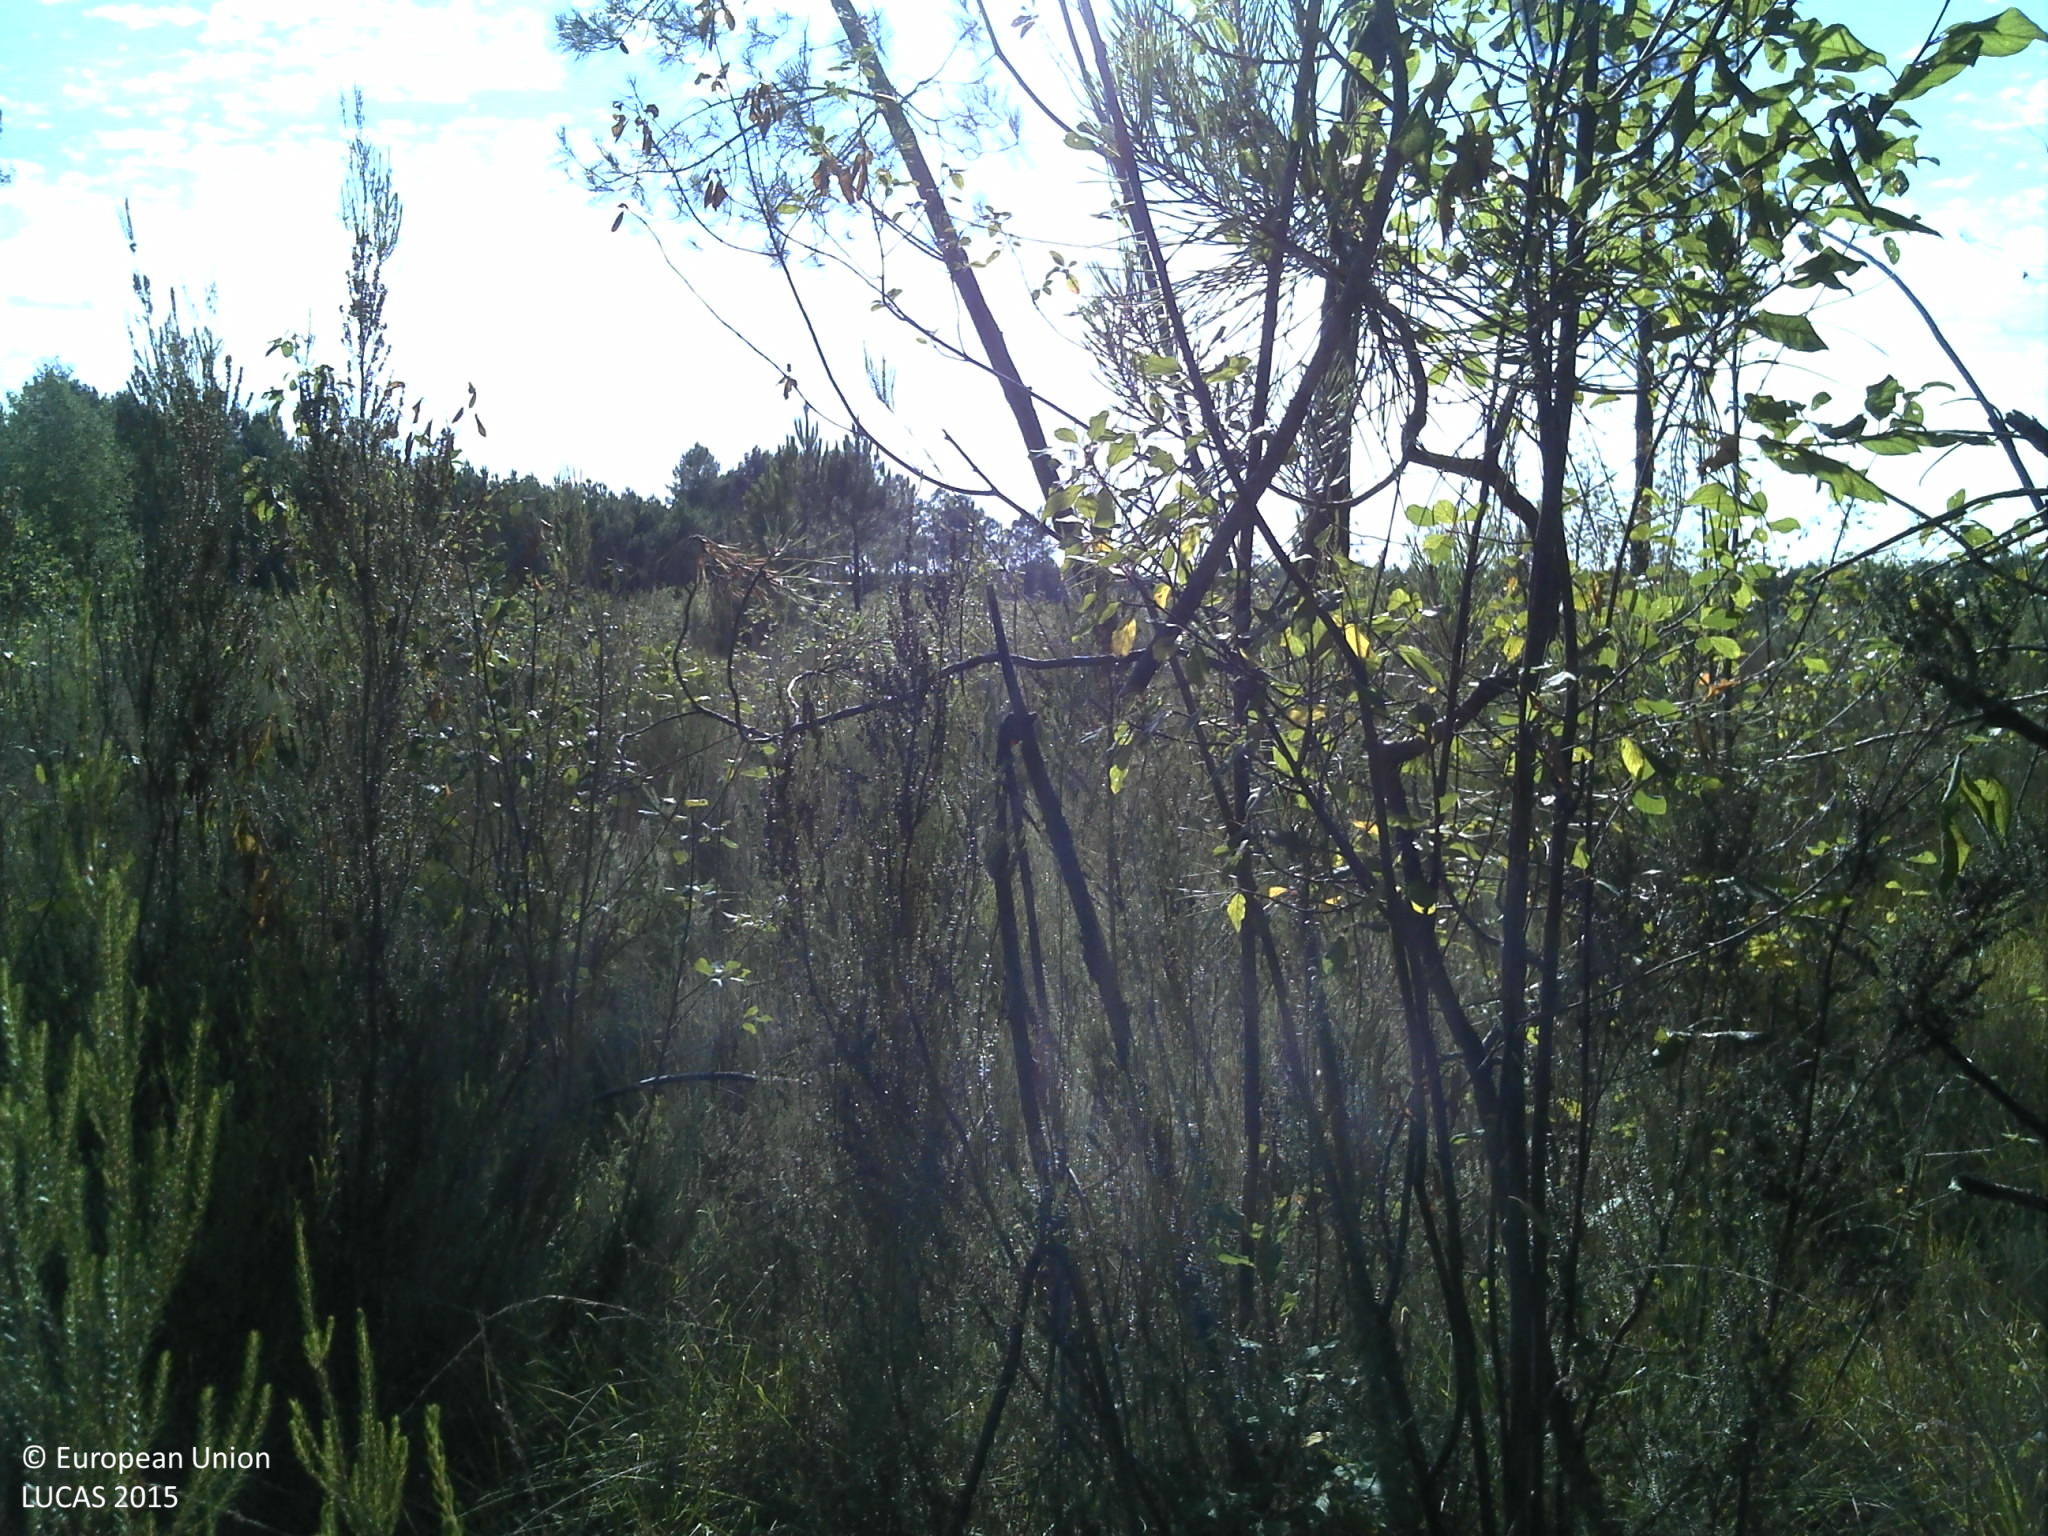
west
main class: Woodland
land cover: Pine dominated coniferous woodland
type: coniferous forest of the mediterranean region
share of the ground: > 75 %
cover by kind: coniferous forest trees 60 %, shrubs 30 %, herbaceous plants 5 %, lichens and mosses 5 %
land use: Forestry
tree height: > 5 m
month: July
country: FR
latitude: 44.5357
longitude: -0.5752
